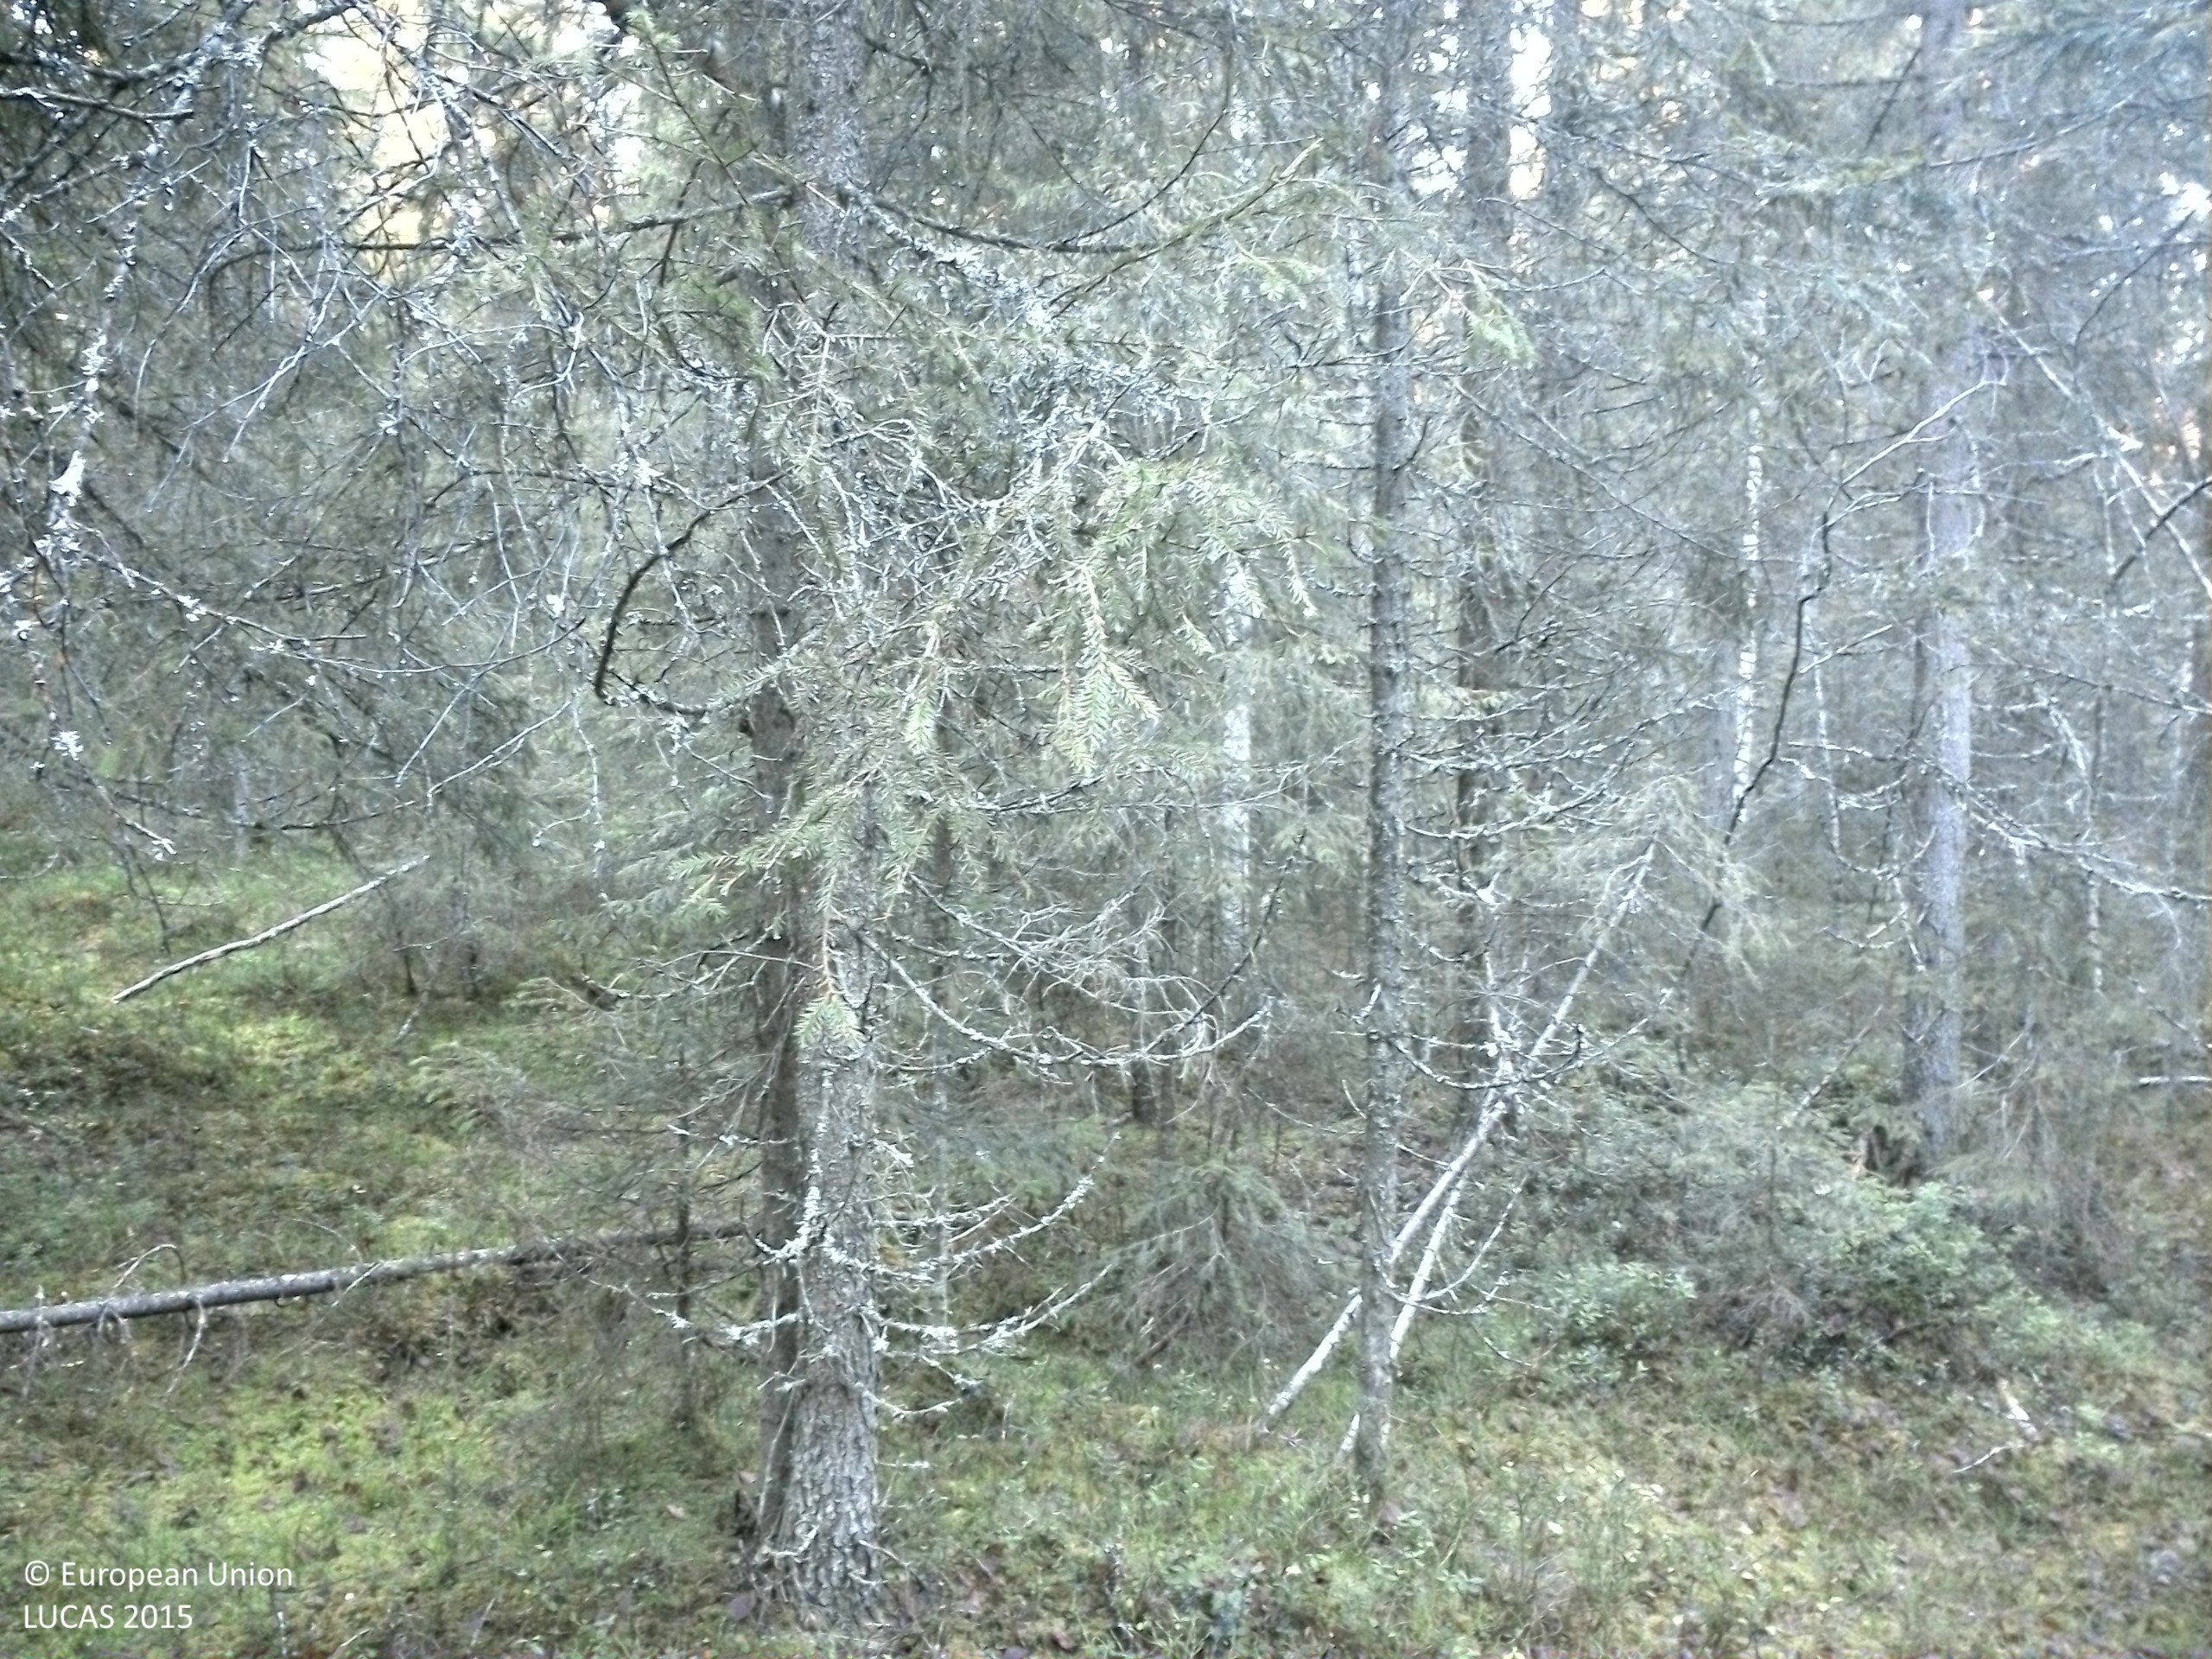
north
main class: Woodland
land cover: Spruce dominated mixed woodland
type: boreal forest
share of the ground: 50 - 75 %
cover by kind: coniferous forest trees 45 %, lichens and mosses 25 %, broadleaved forest trees 15 %, shrubs 15 %
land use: Forestry
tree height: > 5 m
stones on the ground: 25 - 50 %
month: October
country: SE
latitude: 63.8675
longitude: 16.0161
